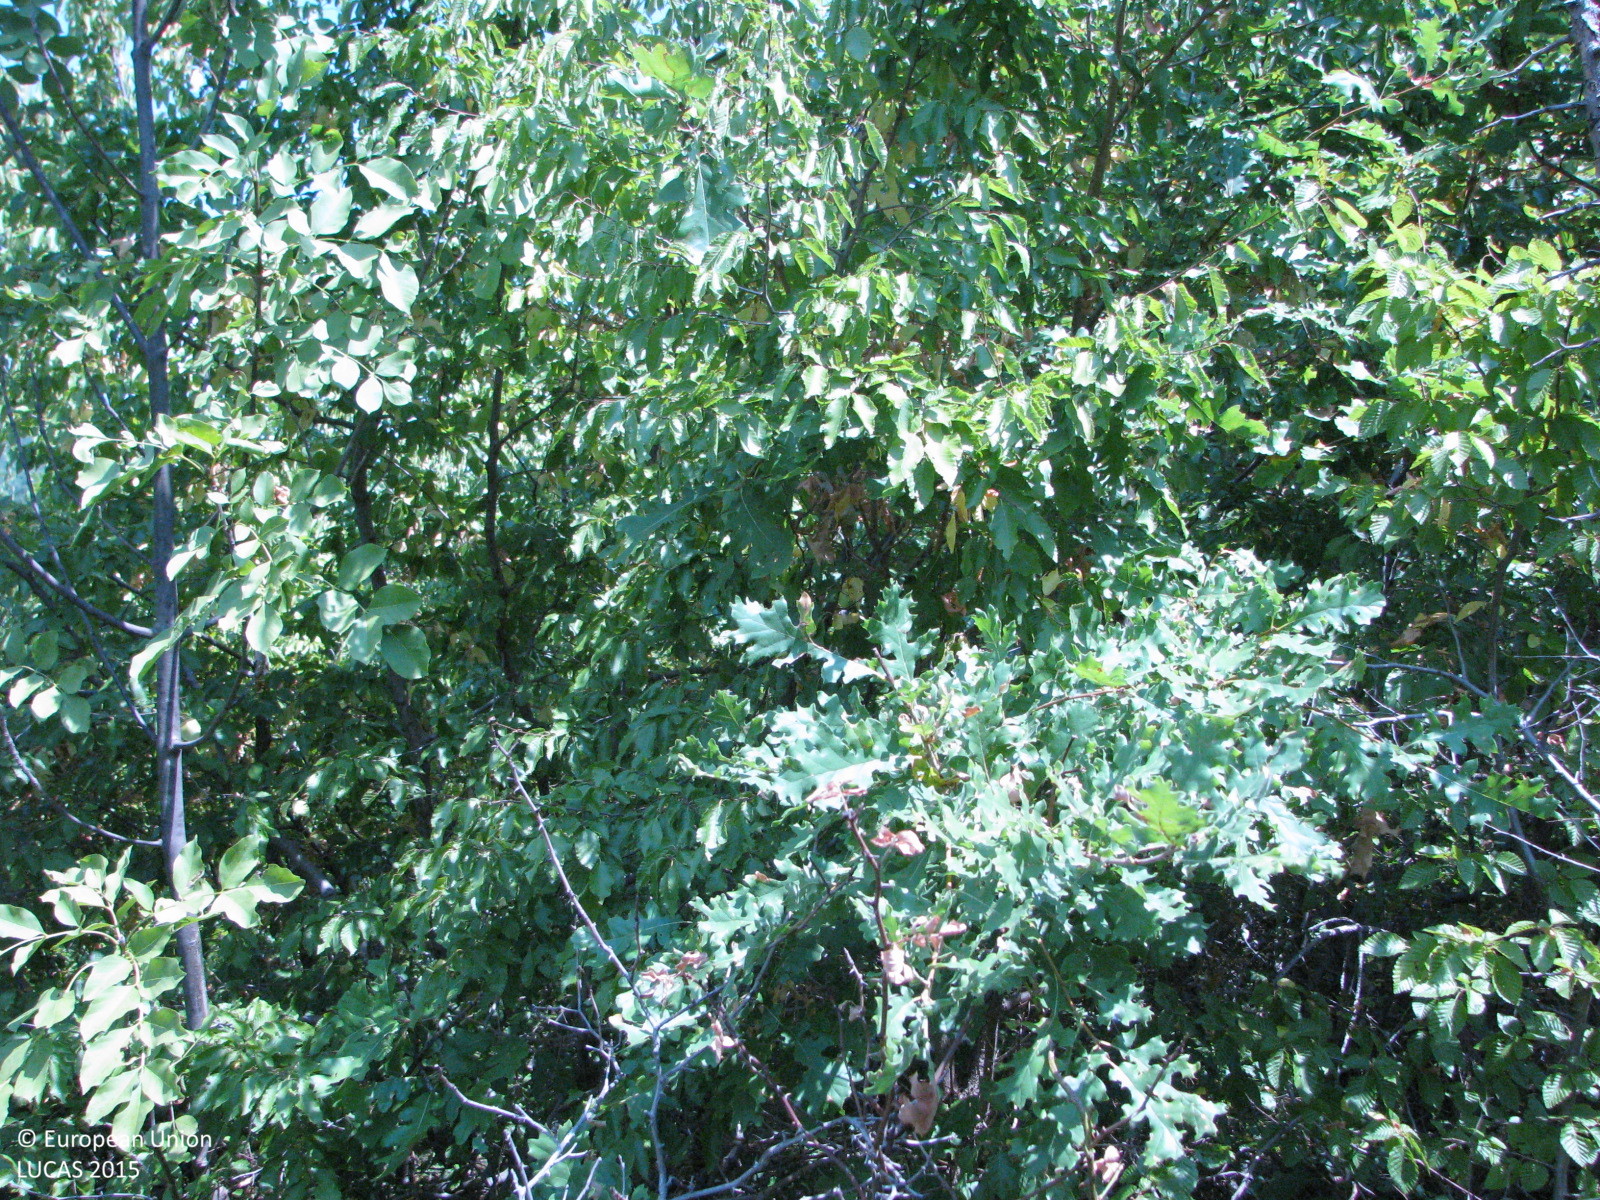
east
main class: Woodland
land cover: Broadleaved woodland
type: hemiboreal forest and nemoral coniferous forest and mixed broadleaved-coniferous forest
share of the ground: 50 - 75 %
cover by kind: broadleaved forest trees 40 %, herbaceous plants 30 %, shrubs 20 %, coniferous forest trees 10 %
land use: Forestry
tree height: > 5 m
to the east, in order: Broadleaved woodland
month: July
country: BG
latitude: 42.6818
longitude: 26.0843
